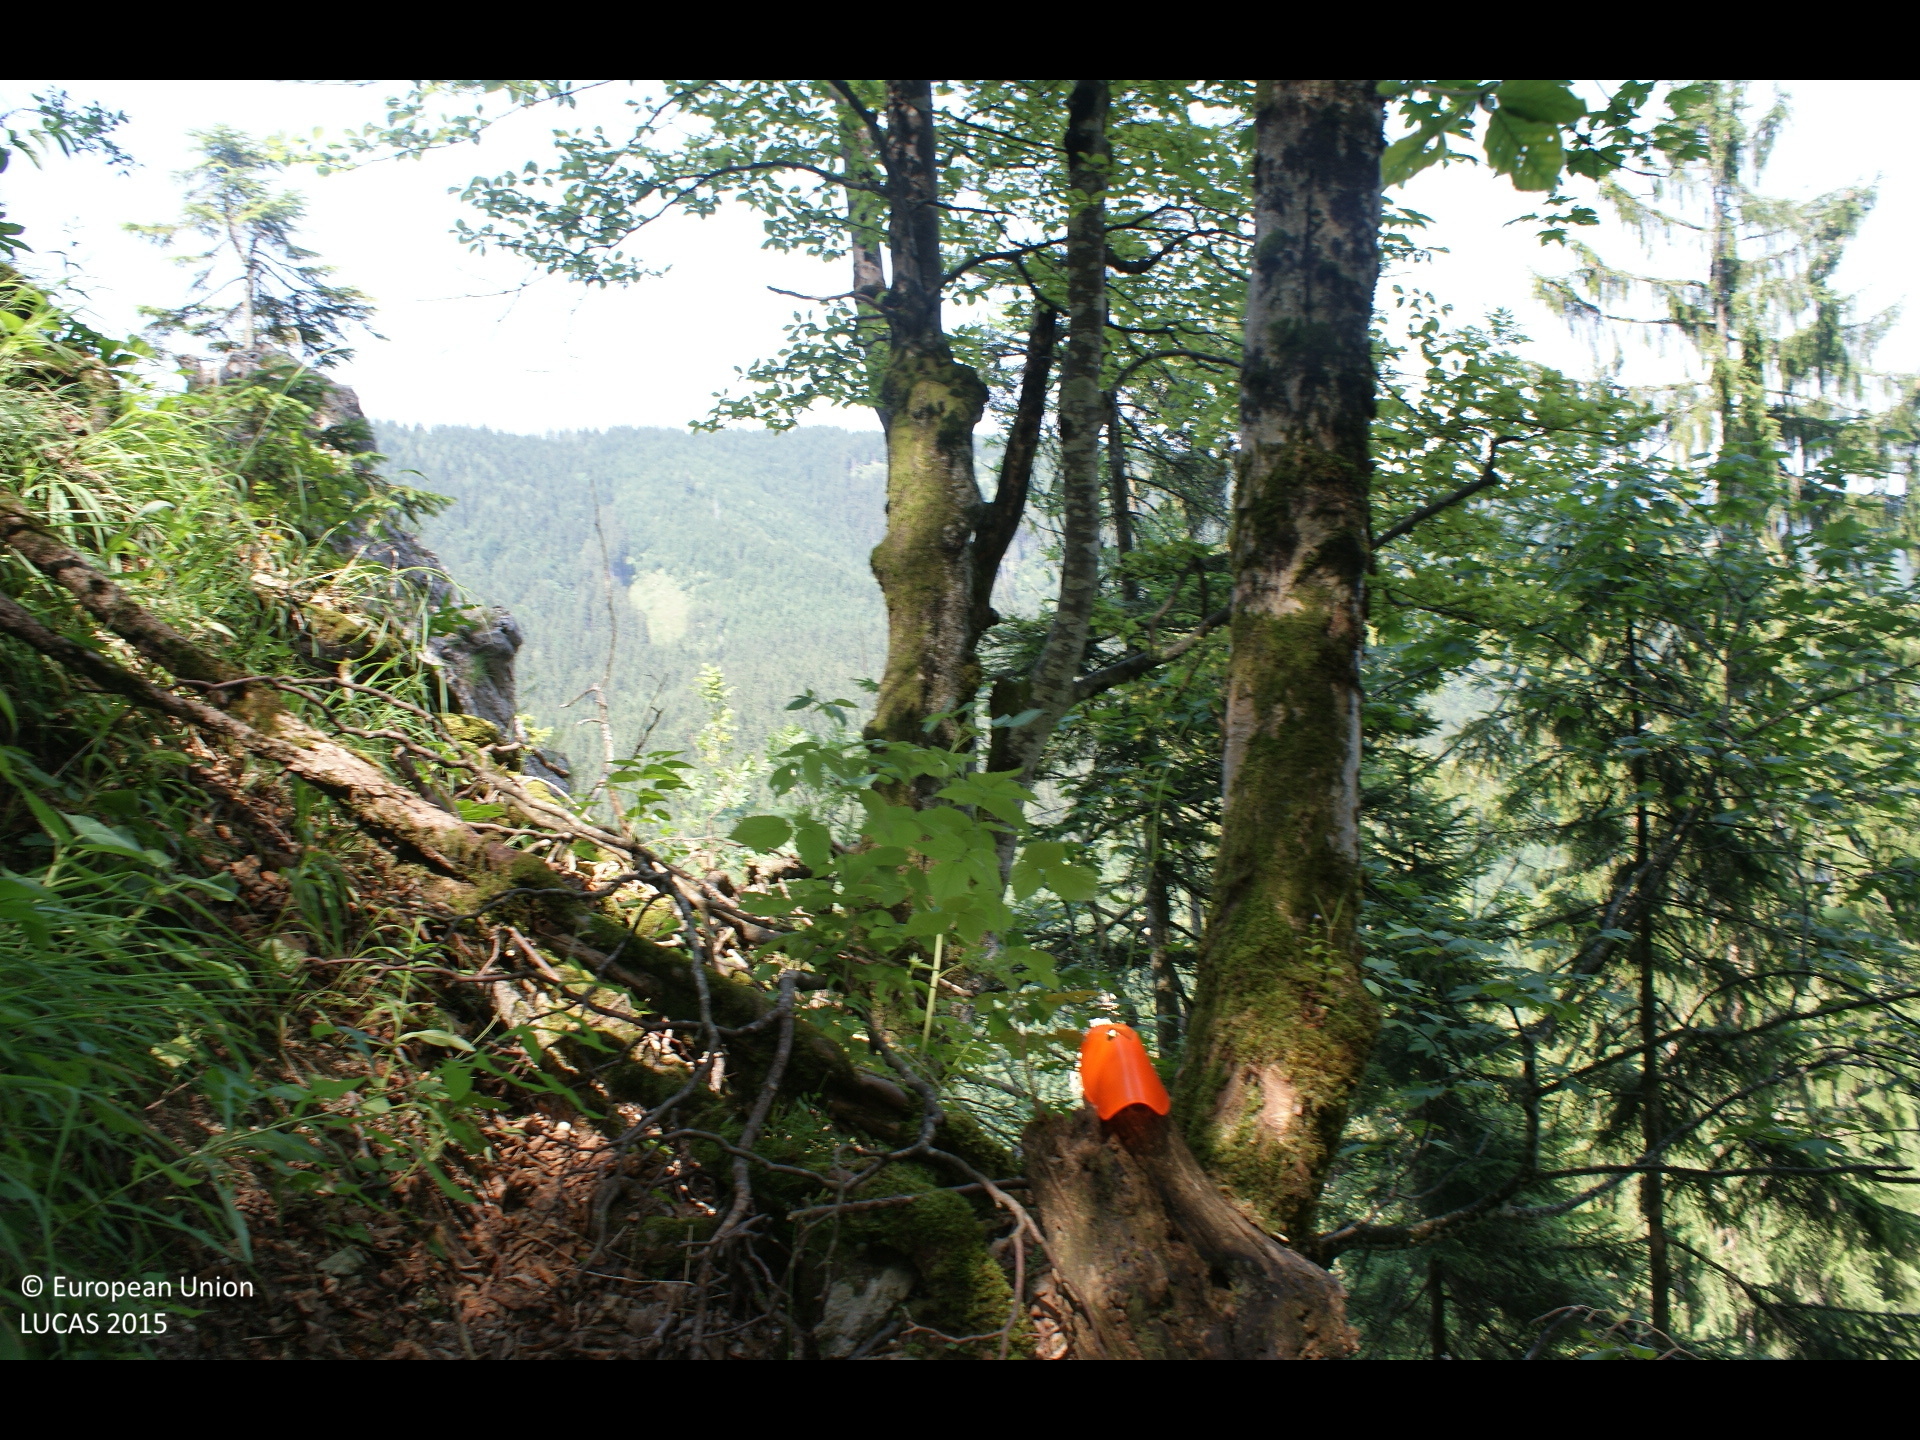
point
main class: Woodland
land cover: Spruce dominated mixed woodland
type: beech forest
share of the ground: > 75 %
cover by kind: broadleaved forest trees 60 %, coniferous forest trees 25 %, shrubs 5 %, herbaceous plants 5 %, consolidated bare surface 5 %
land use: Forestry
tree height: > 5 m
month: July
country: AT
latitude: 47.8399
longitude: 13.6198
